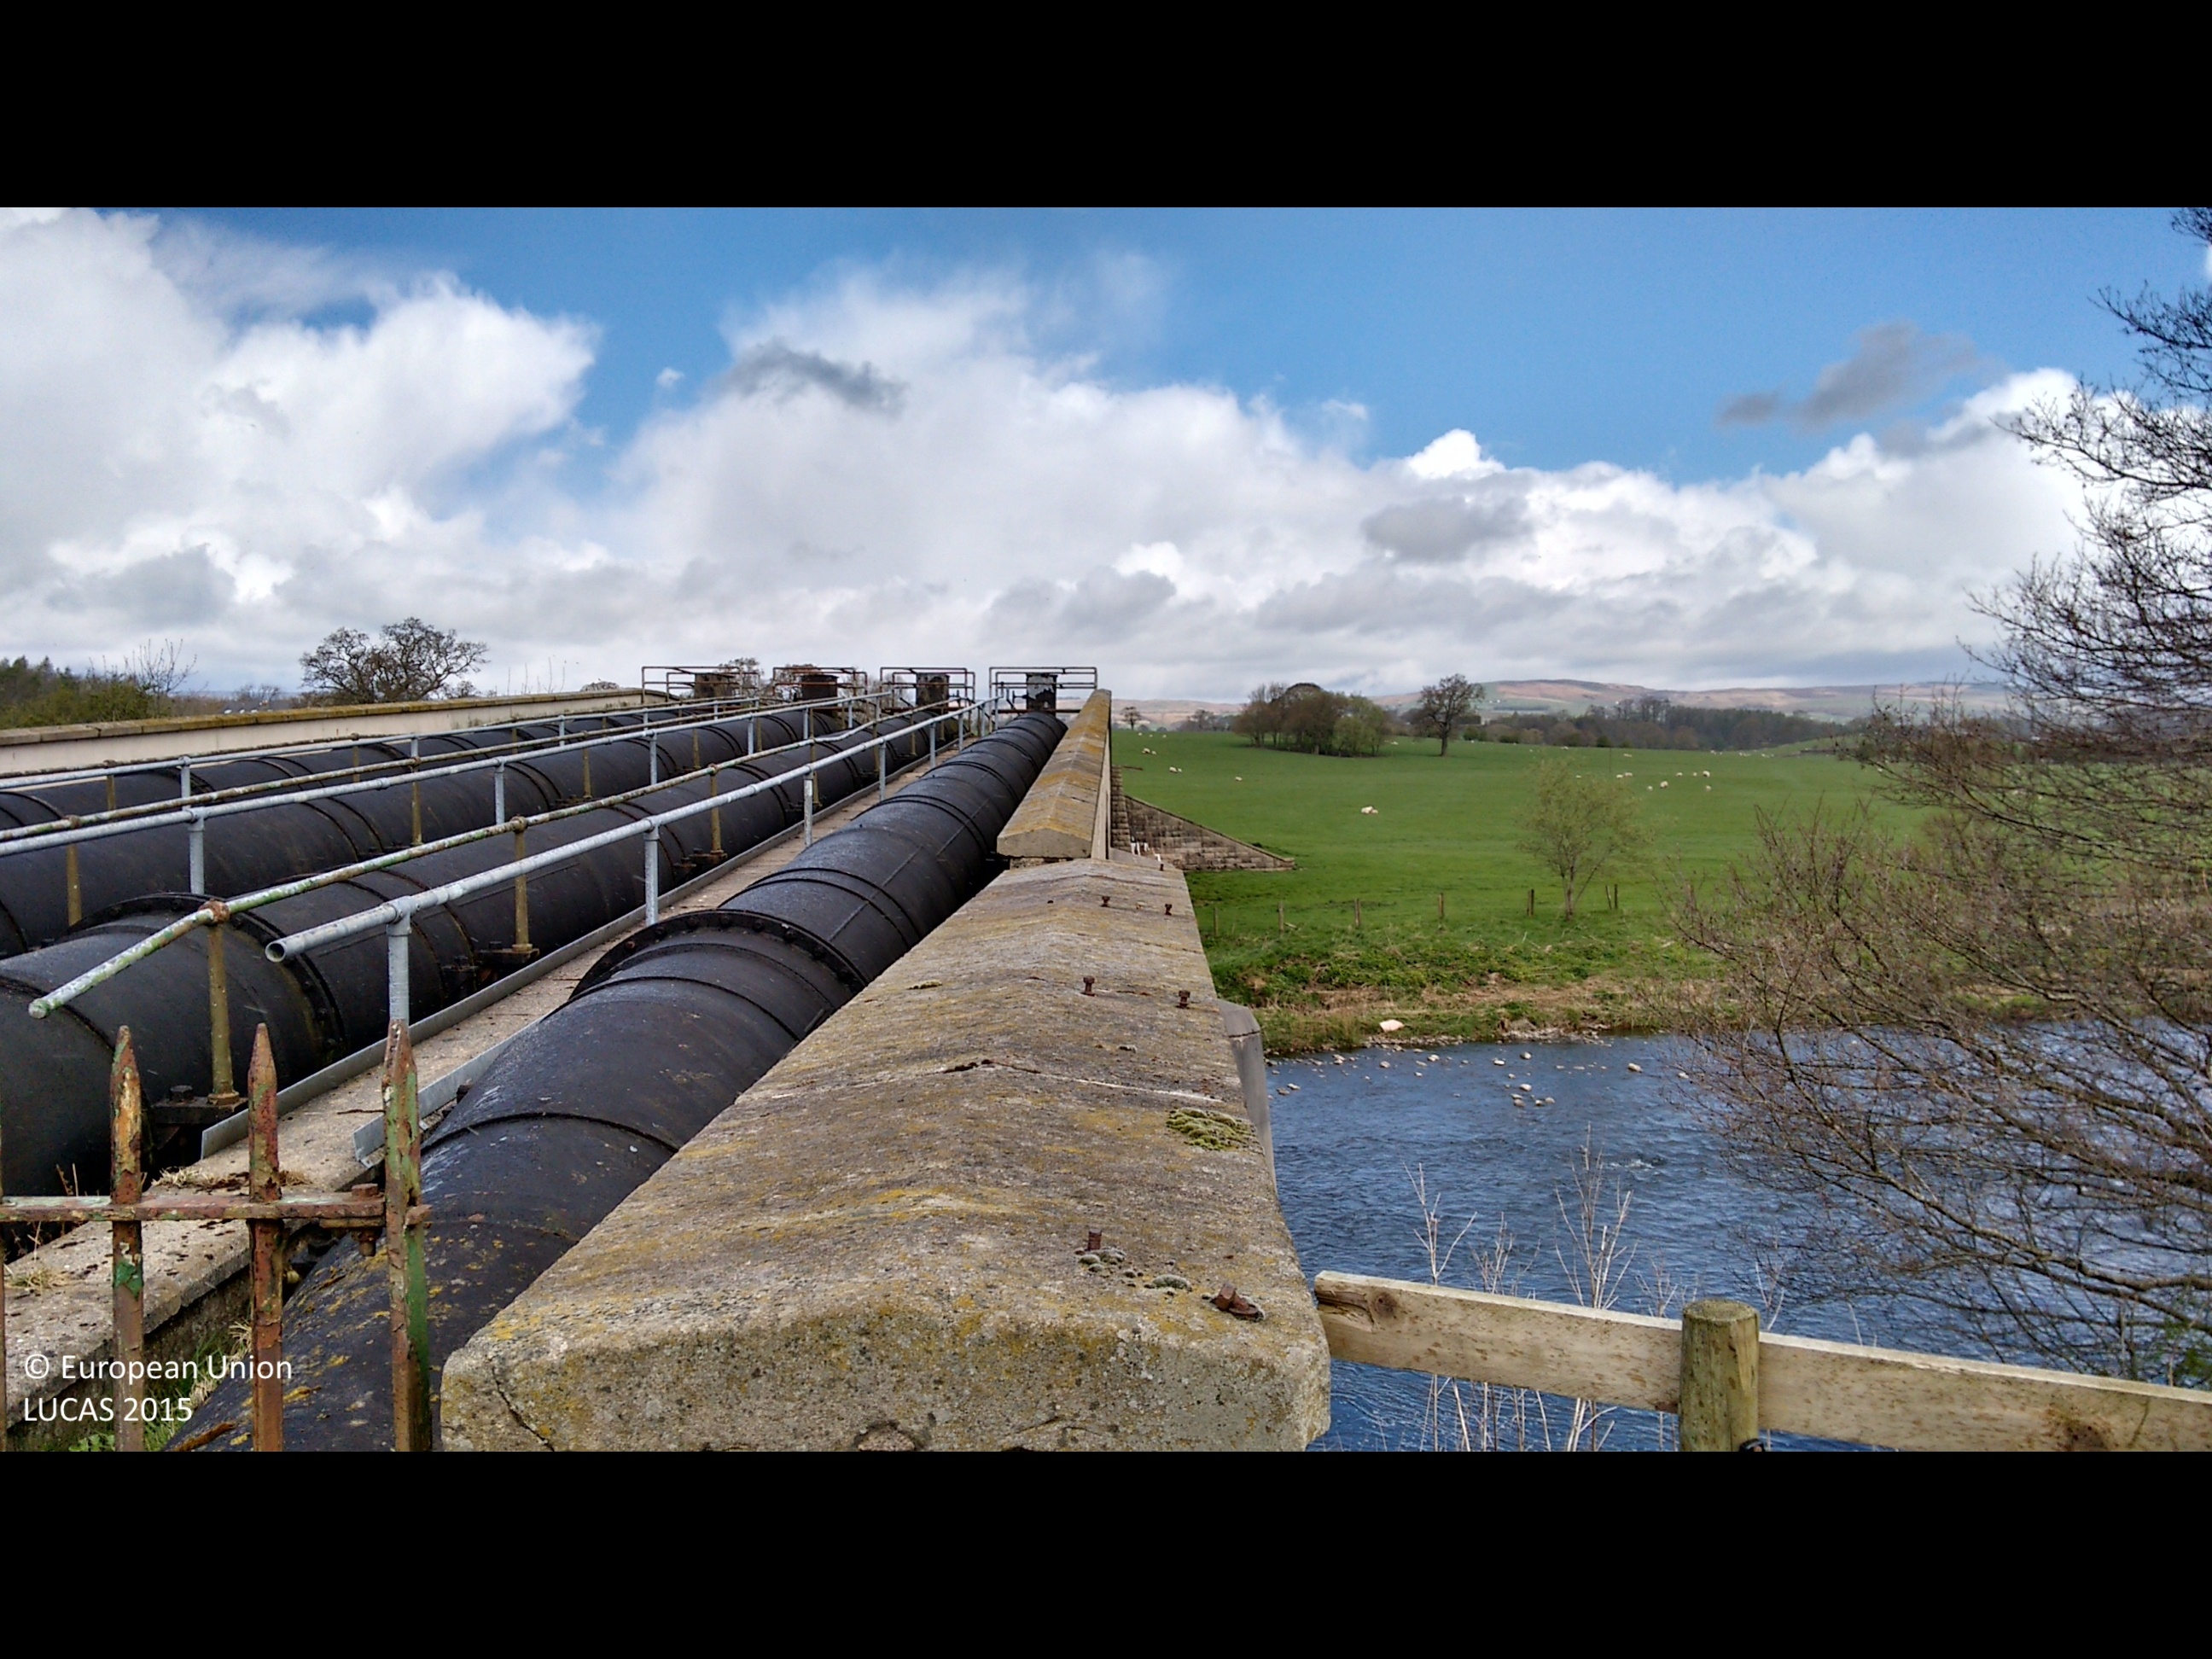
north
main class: Grassland
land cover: Grassland without tree/shrub cover
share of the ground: > 75 %
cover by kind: herbaceous plants 100 %
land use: Agriculture (excluding fallow land and kitchen gardens)
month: April
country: GB
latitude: 53.8513
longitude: -2.4225
